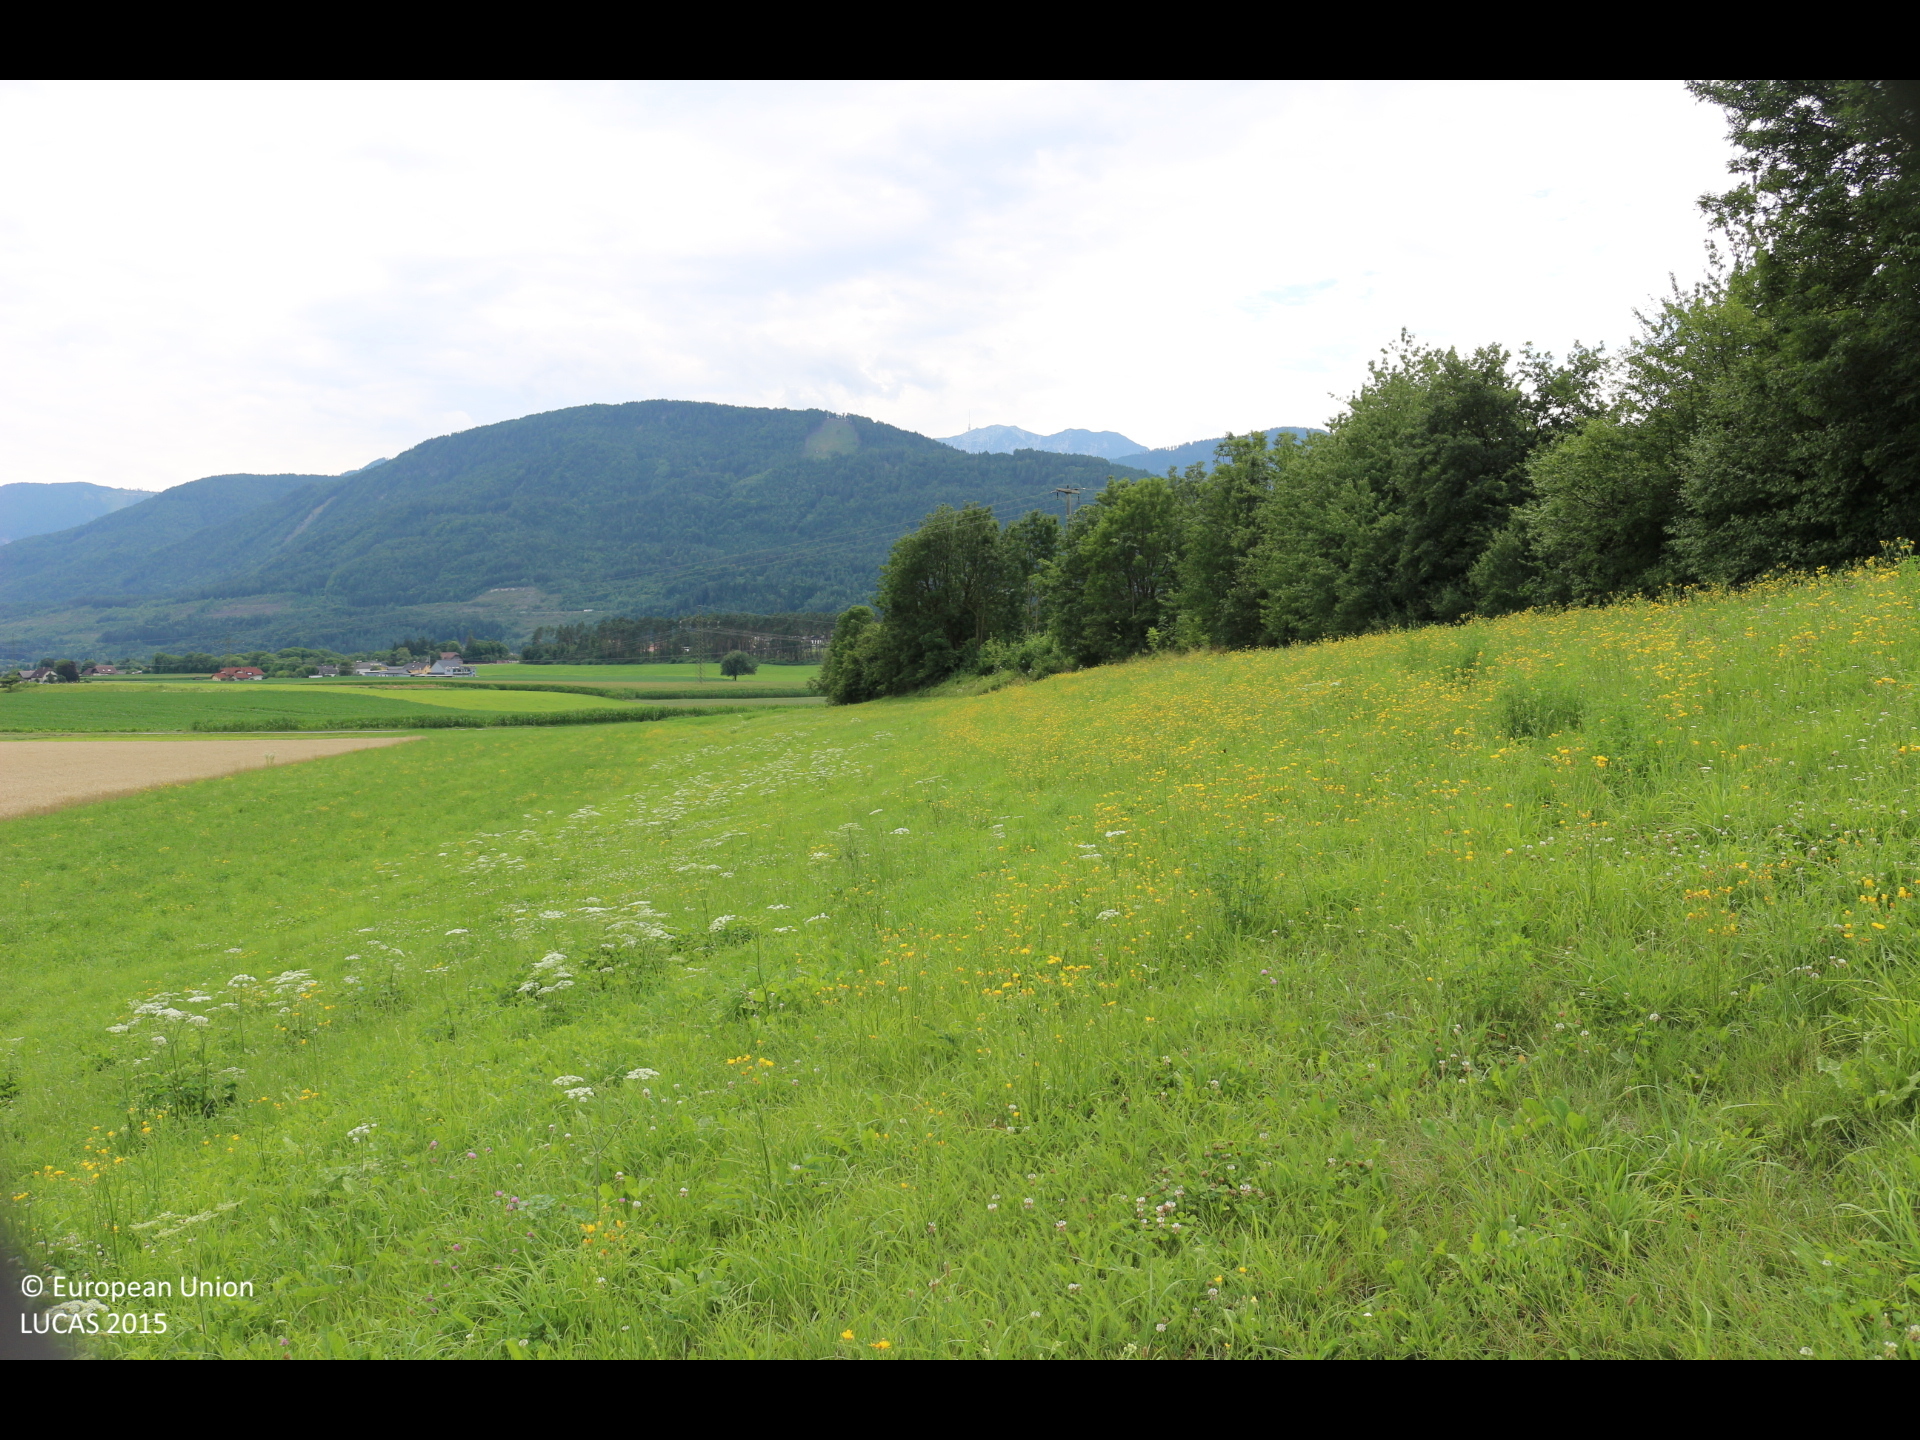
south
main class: Grassland
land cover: Grassland without tree/shrub cover
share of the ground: > 75 %
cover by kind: herbaceous plants 100 %
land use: Agriculture (excluding fallow land and kitchen gardens)
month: July
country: AT
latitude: 46.7028
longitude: 13.6725
